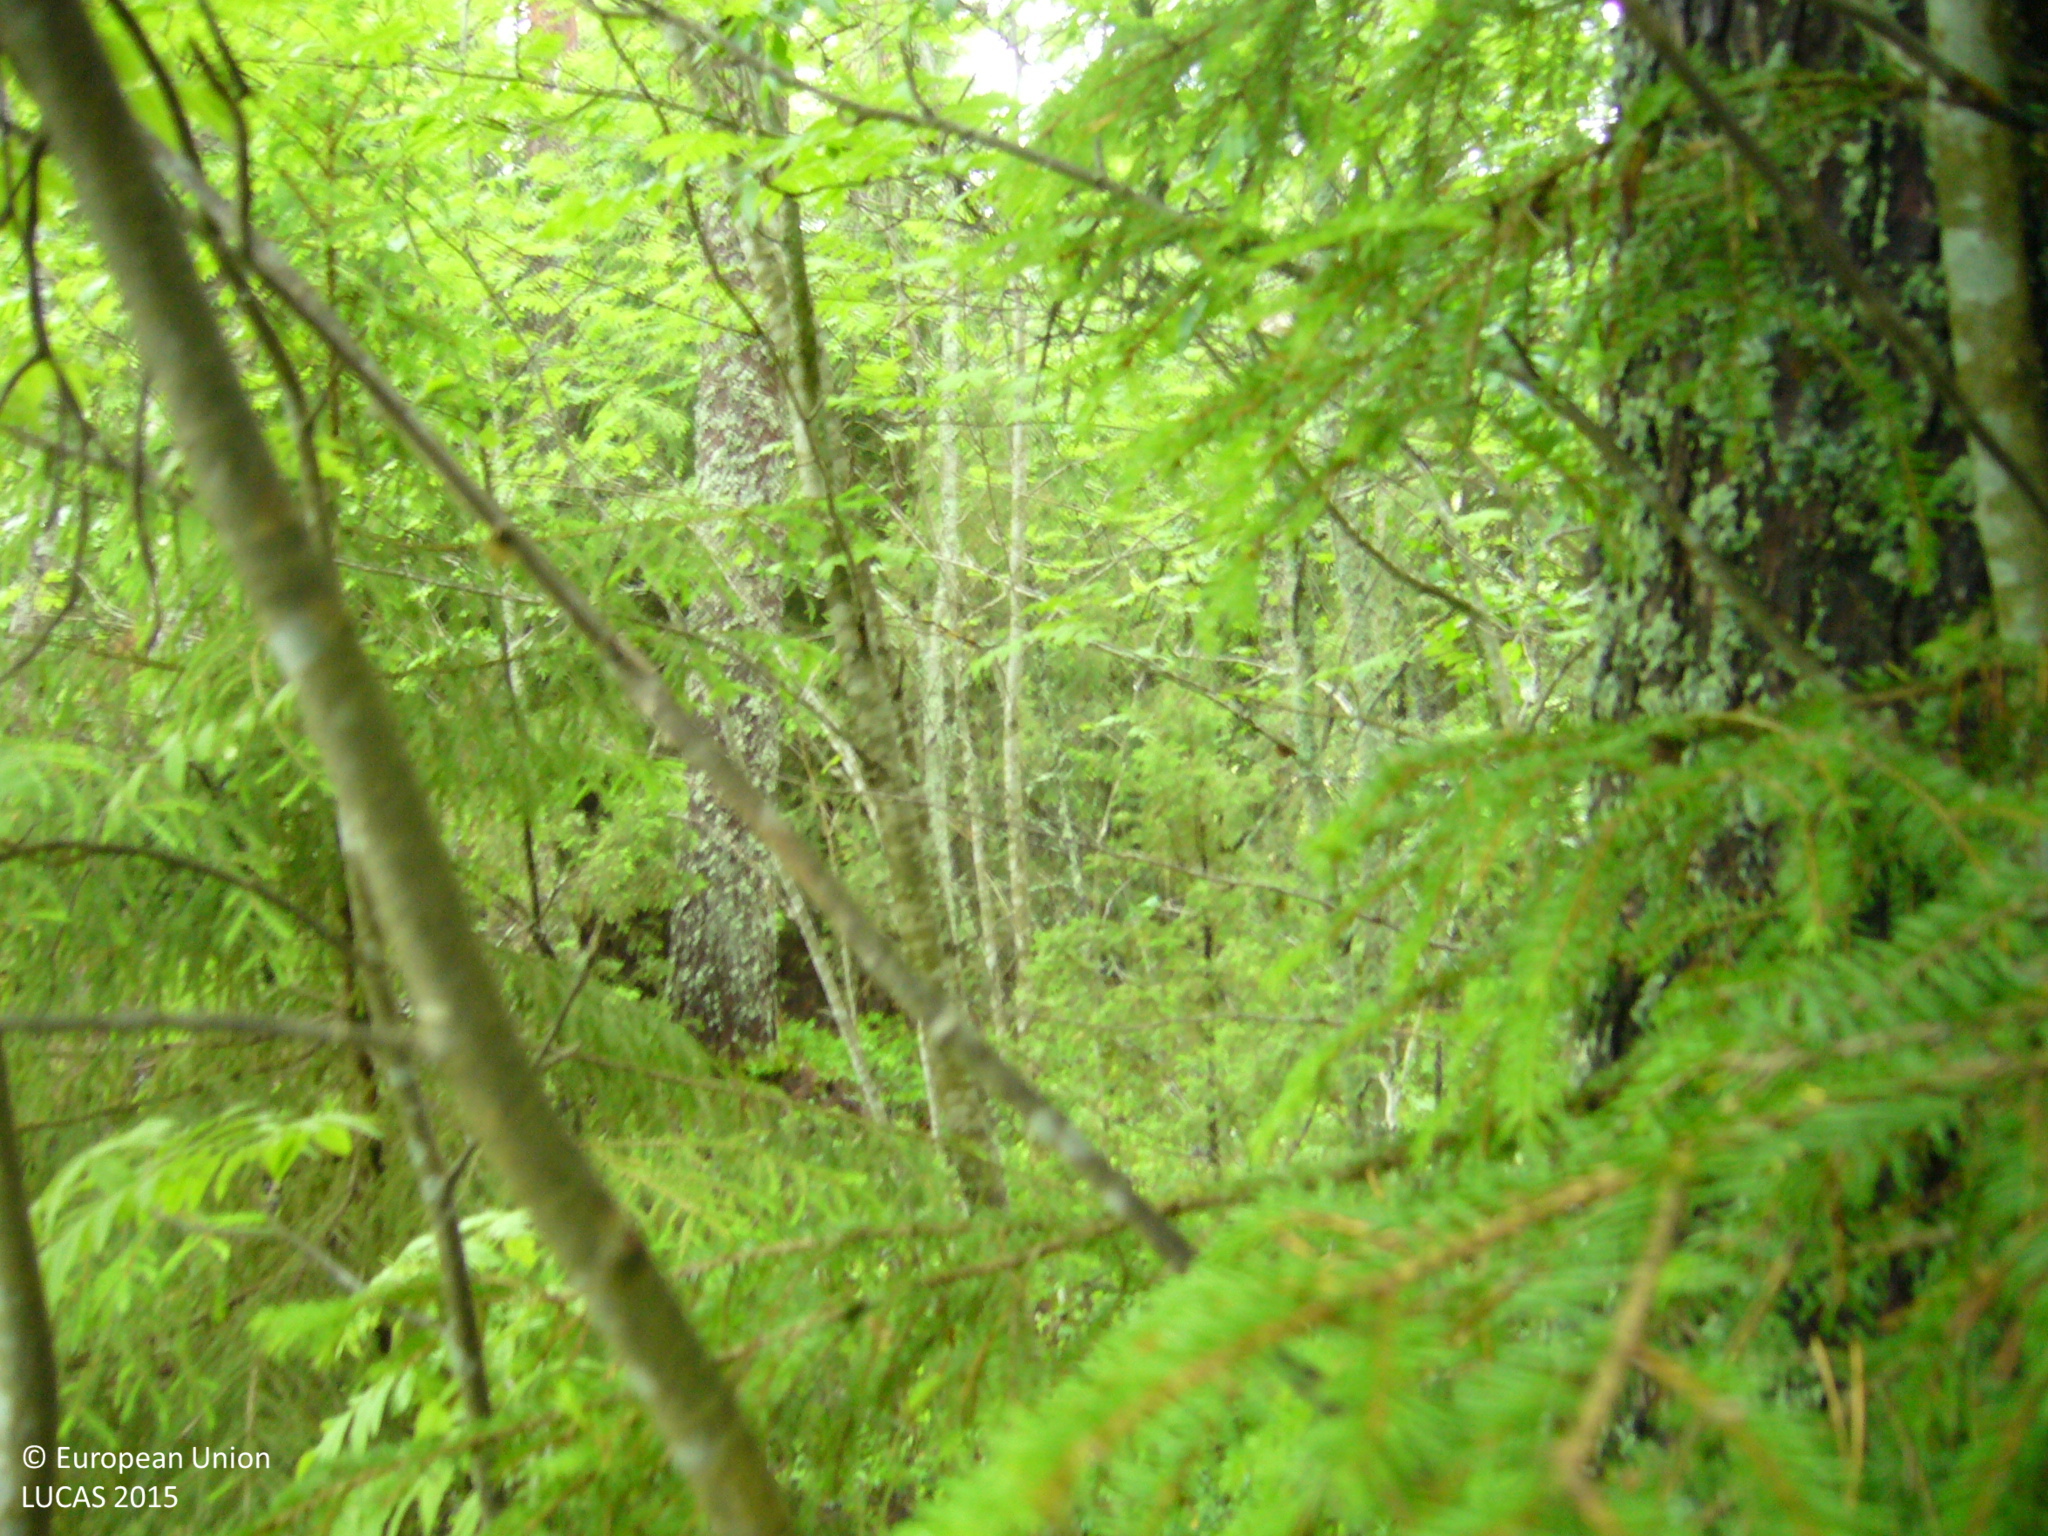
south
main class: Woodland
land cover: Other mixed woodland
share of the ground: > 75 %
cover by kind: broadleaved forest trees 55 %, coniferous forest trees 45 %
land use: Forestry
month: June
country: FI
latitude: 63.5929
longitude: 26.3862
